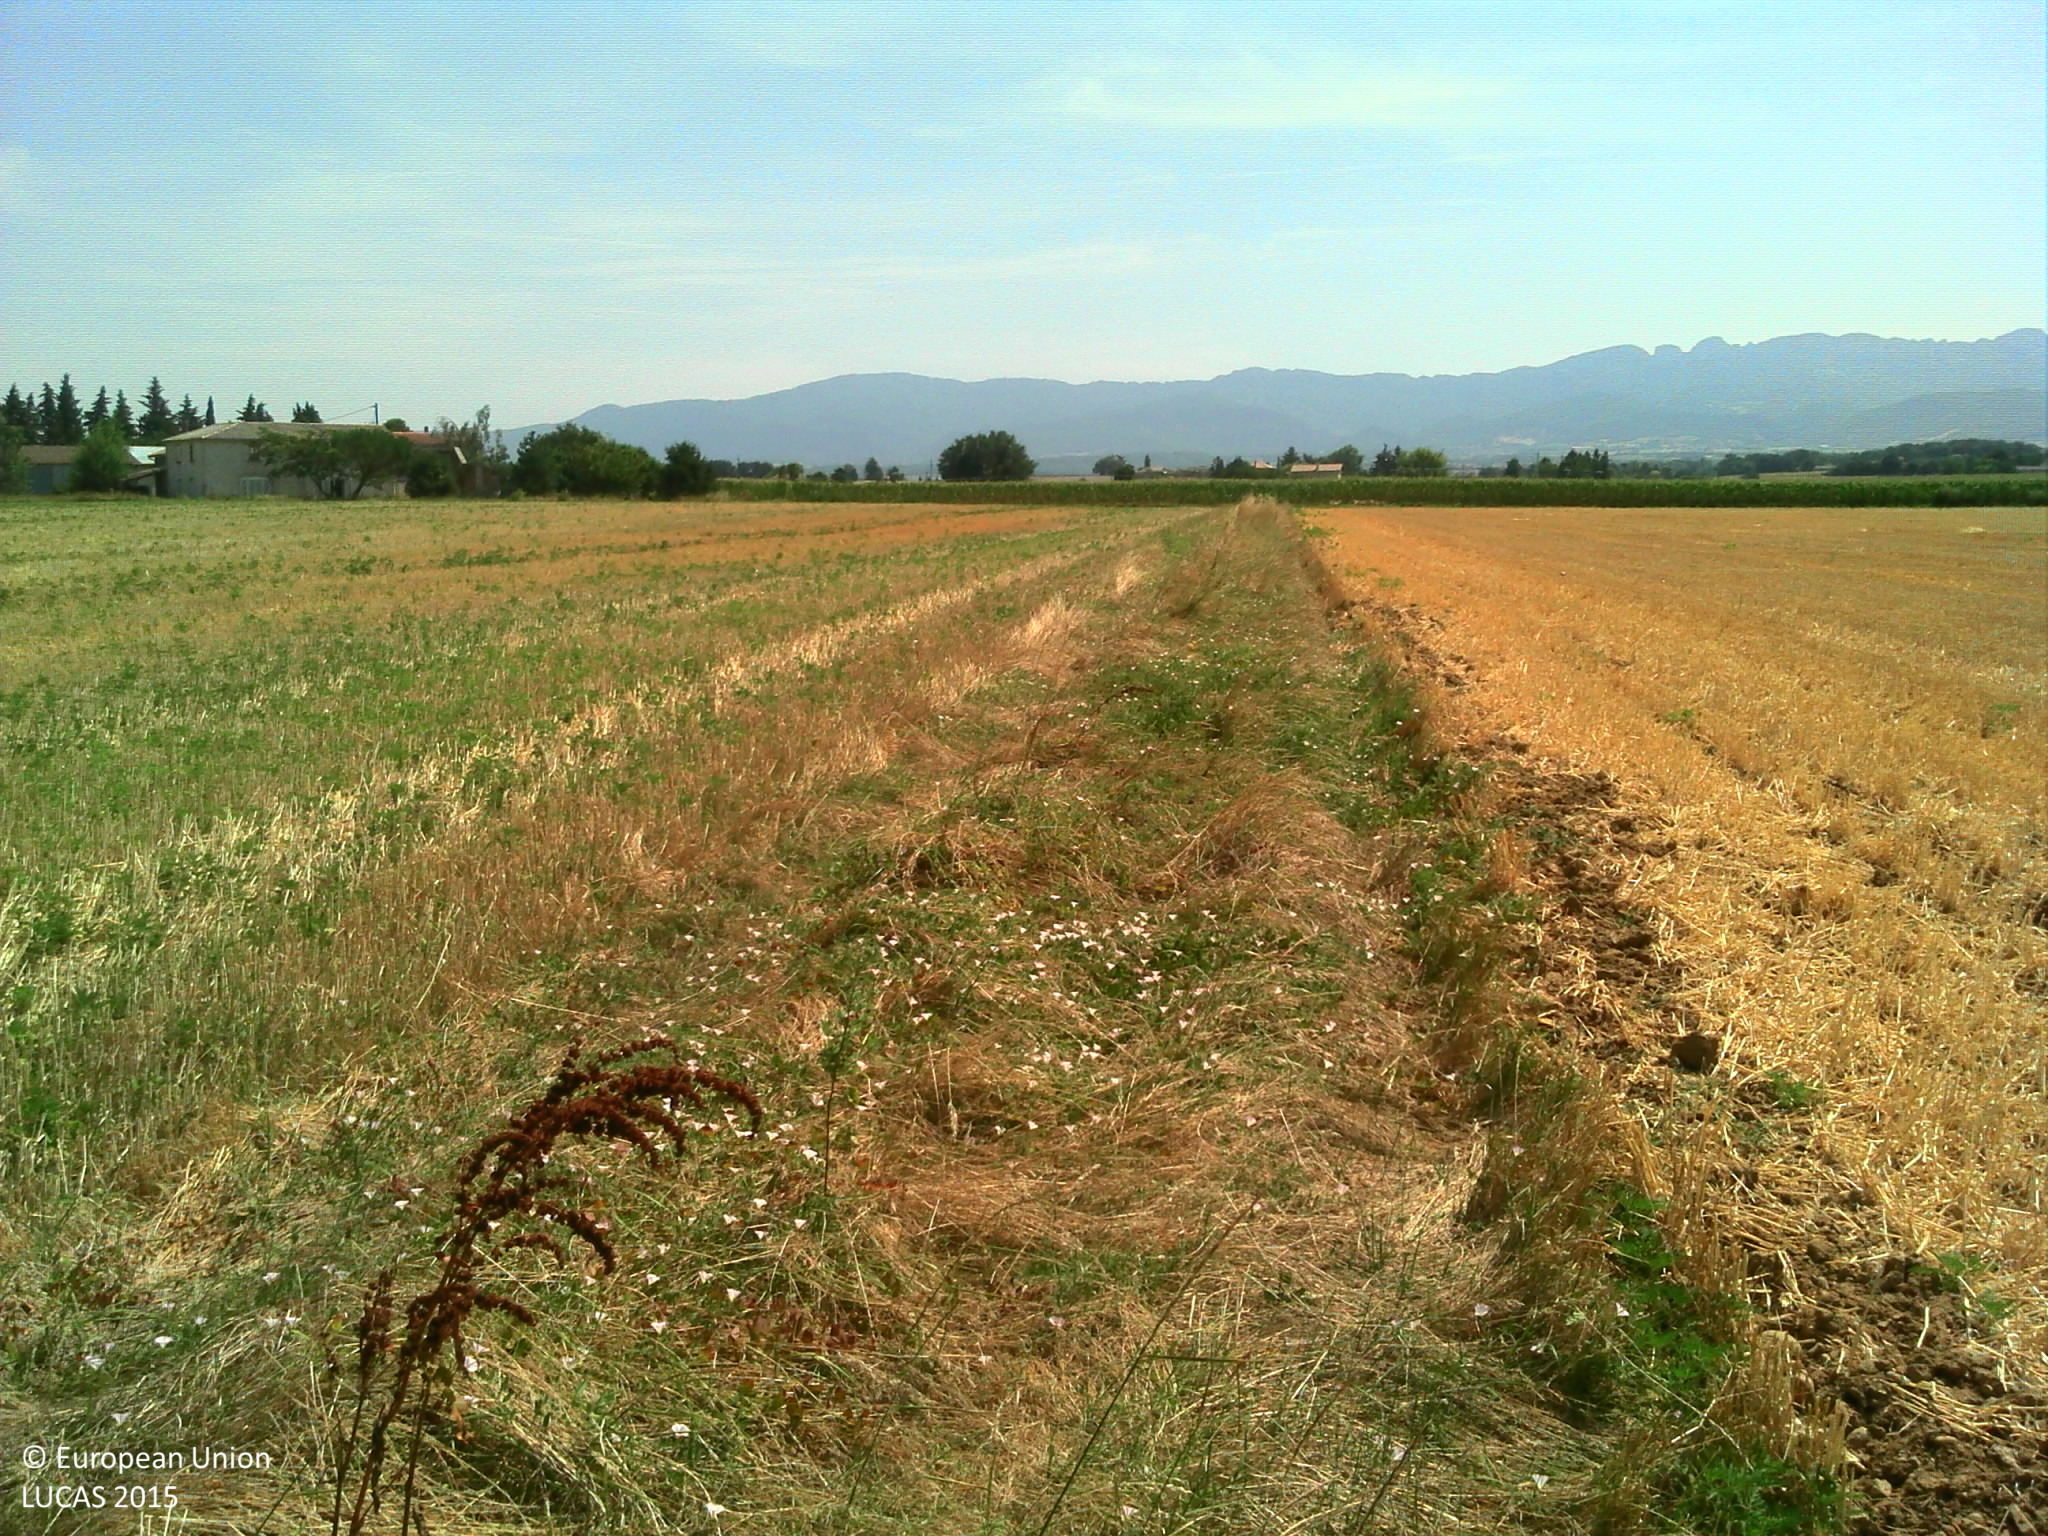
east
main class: Cropland
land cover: Barley
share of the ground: > 75 %
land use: Agriculture (excluding fallow land and kitchen gardens)
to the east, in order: Grass margins; Barley; Grass margins; Maize
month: July
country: FR
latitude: 44.9897
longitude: 5.0210
